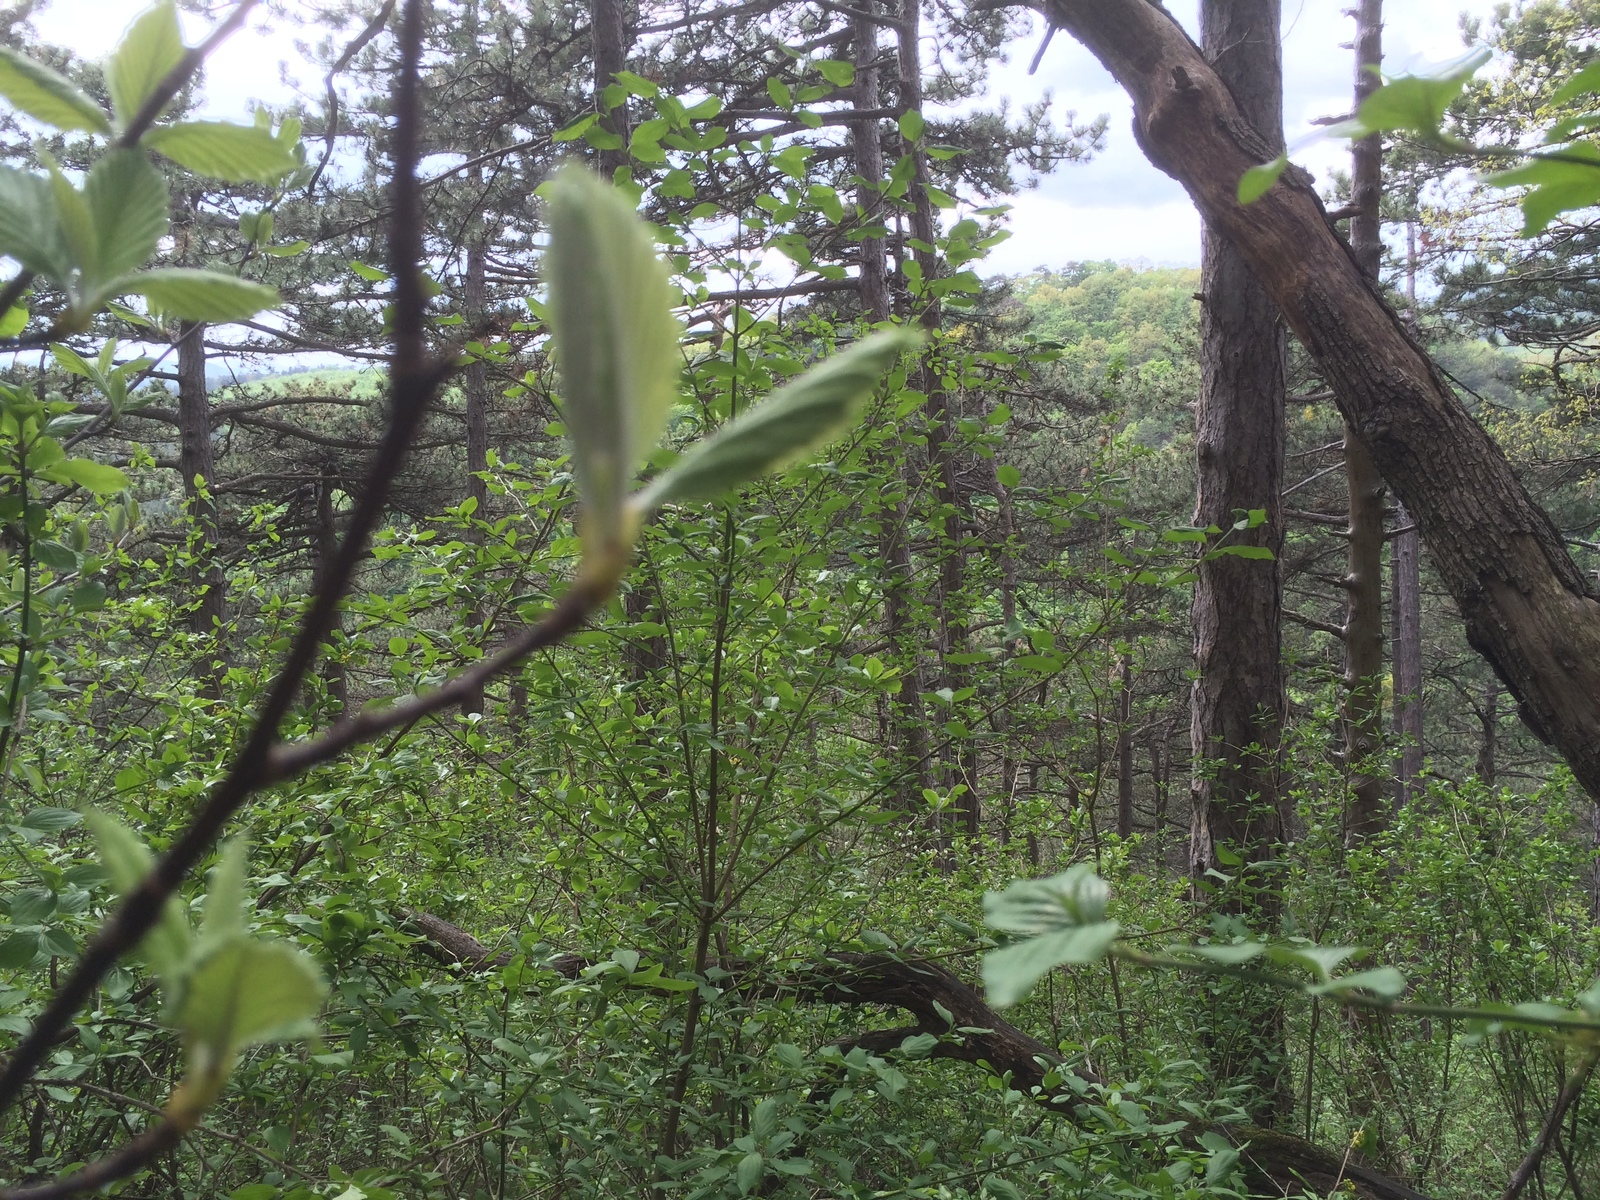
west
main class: Woodland
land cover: Pine dominated mixed woodland
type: alpine coniferous forest
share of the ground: > 75 %
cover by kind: coniferous forest trees 75 %, broadleaved forest trees 25 %
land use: Forestry
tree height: > 5 m
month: May
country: AT
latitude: 48.0661
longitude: 16.2175
